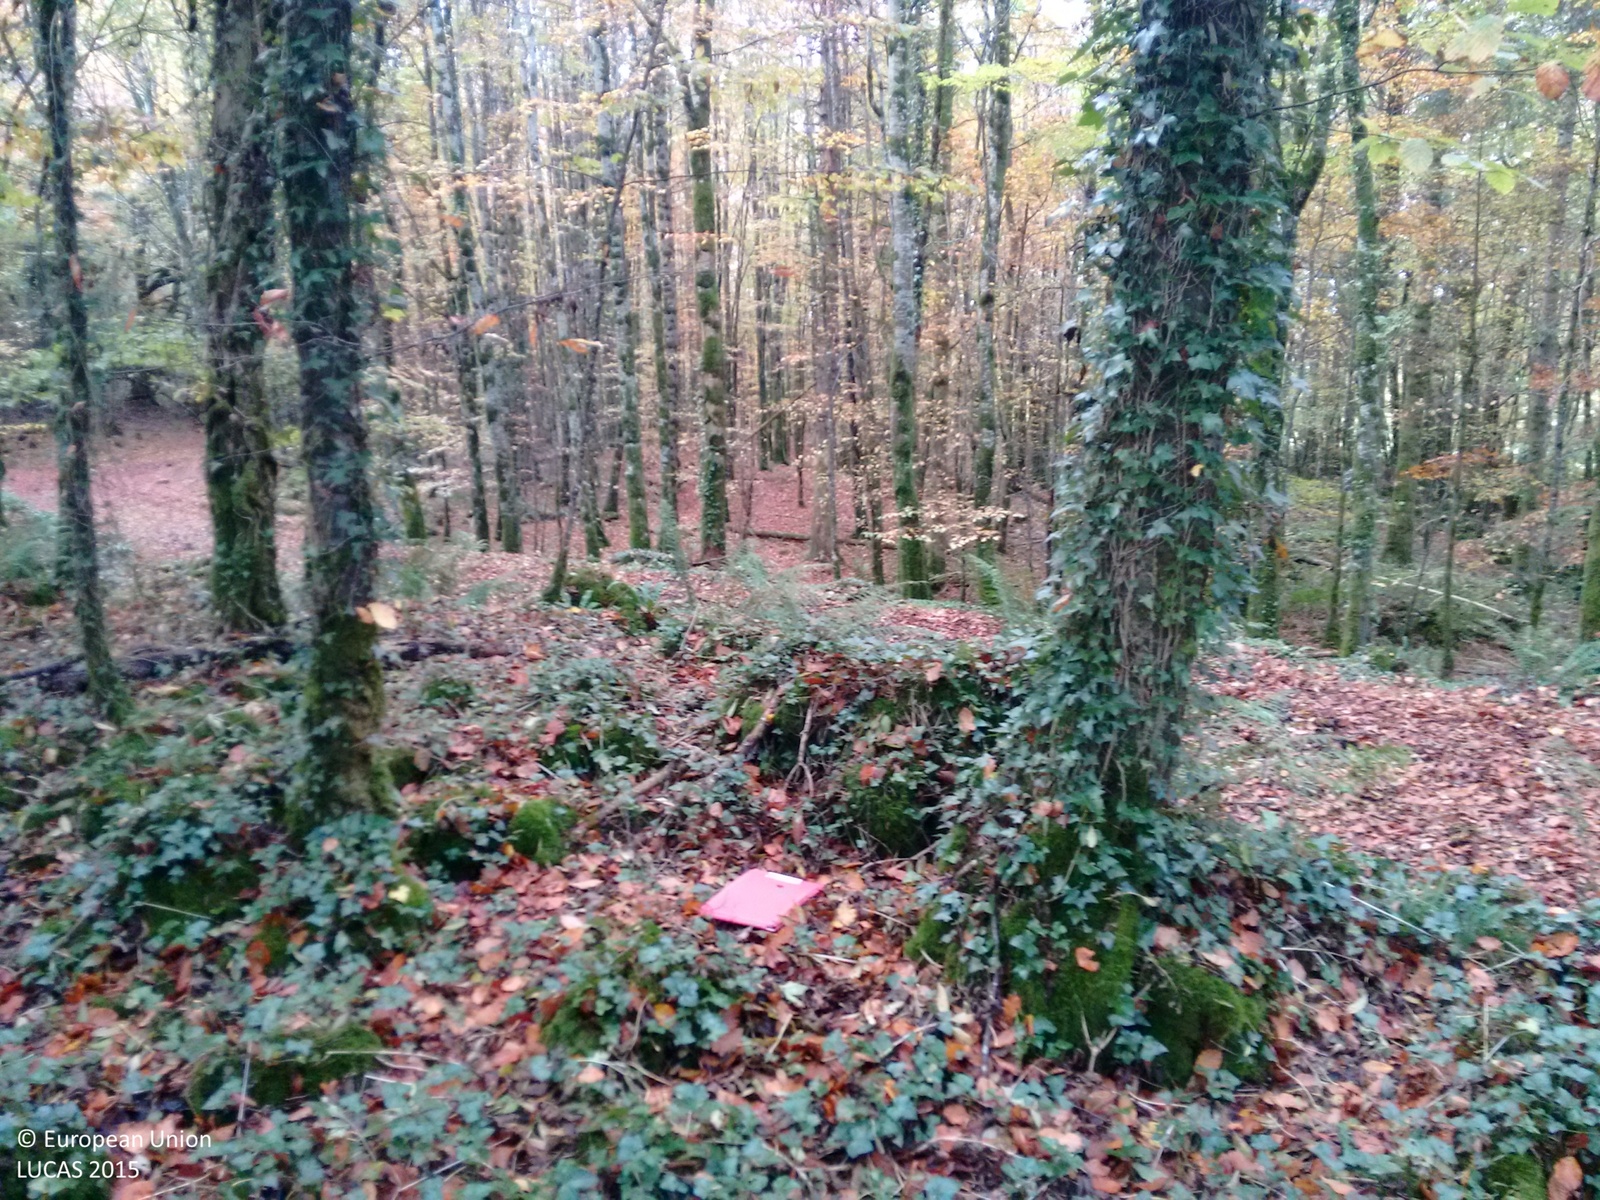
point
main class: Woodland
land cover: Broadleaved woodland
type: acidophilous oak and oak-birch forest
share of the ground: > 75 %
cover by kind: broadleaved forest trees 95 %, herbaceous plants 5 %
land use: Amenities, museums, leisure
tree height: > 5 m
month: October
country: IE
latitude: 53.9738
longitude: -8.2498
